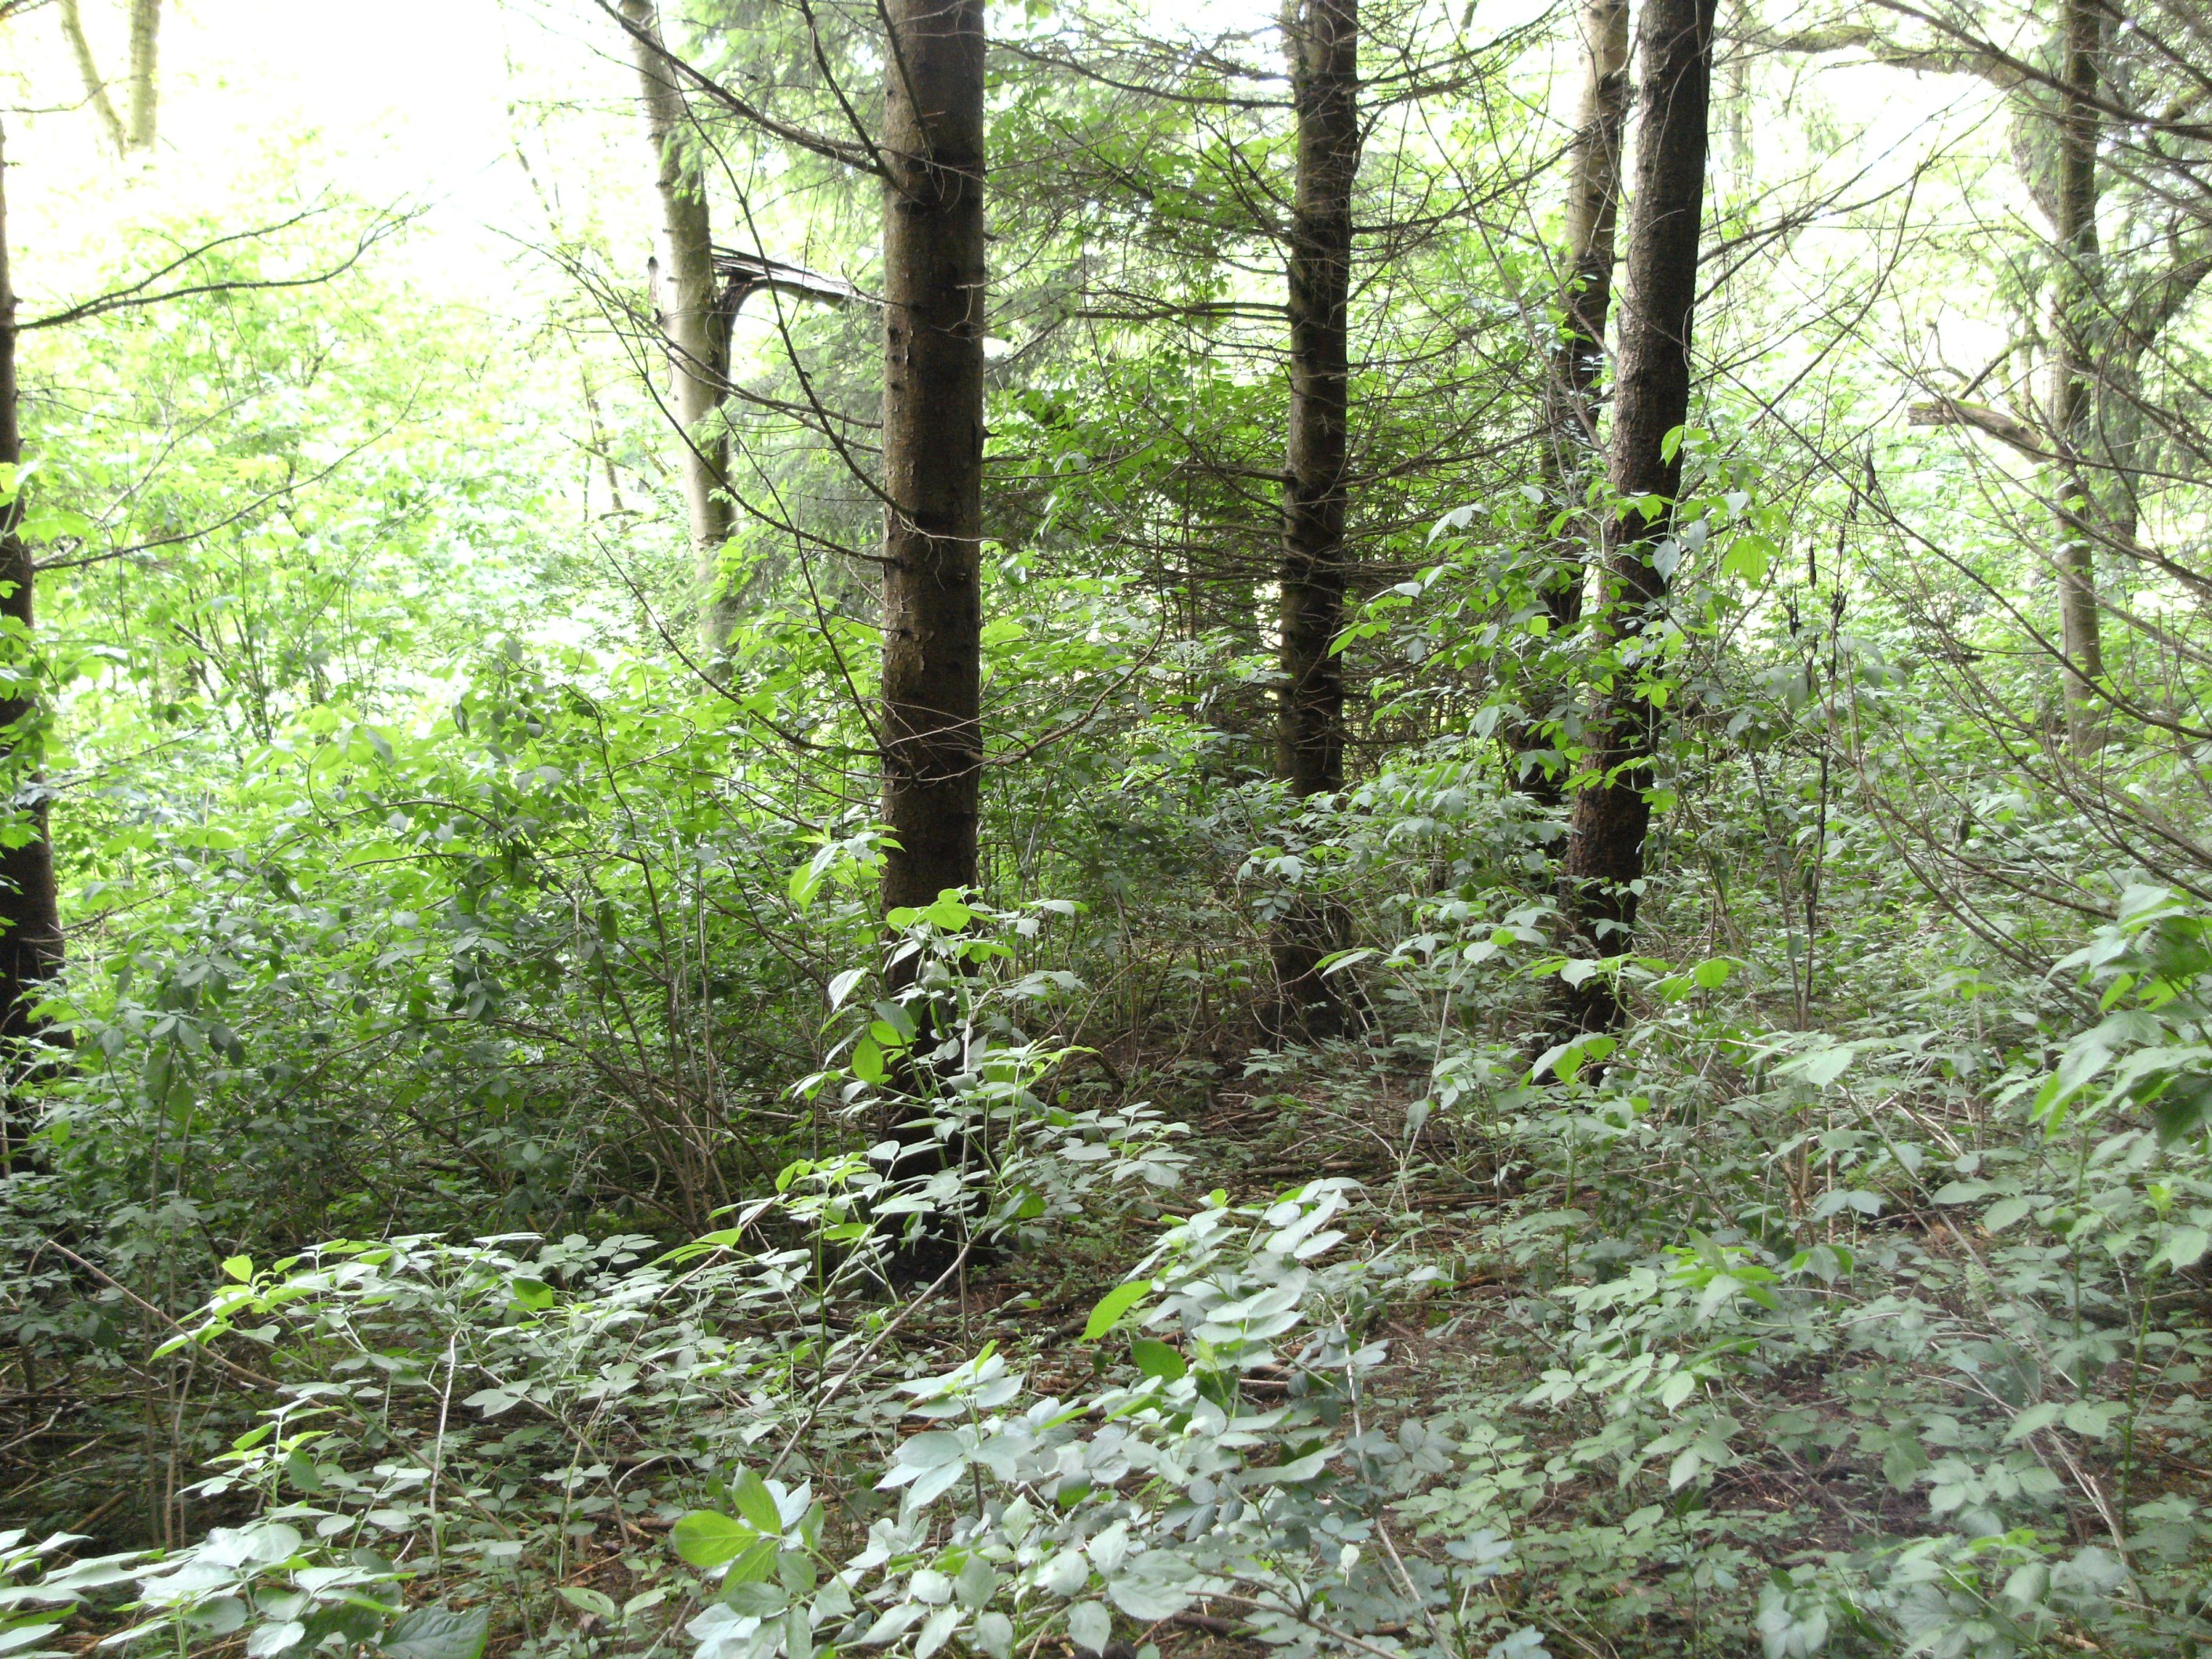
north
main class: Woodland
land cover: Other mixed woodland
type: hemiboreal forest and nemoral coniferous forest and mixed broadleaved-coniferous forest
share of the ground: > 75 %
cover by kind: coniferous forest trees 60 %, broadleaved forest trees 30 %, shrubs 5 %, herbaceous plants 5 %
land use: Forestry
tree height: > 5 m
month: May
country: AT
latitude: 48.1314
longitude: 14.0441
